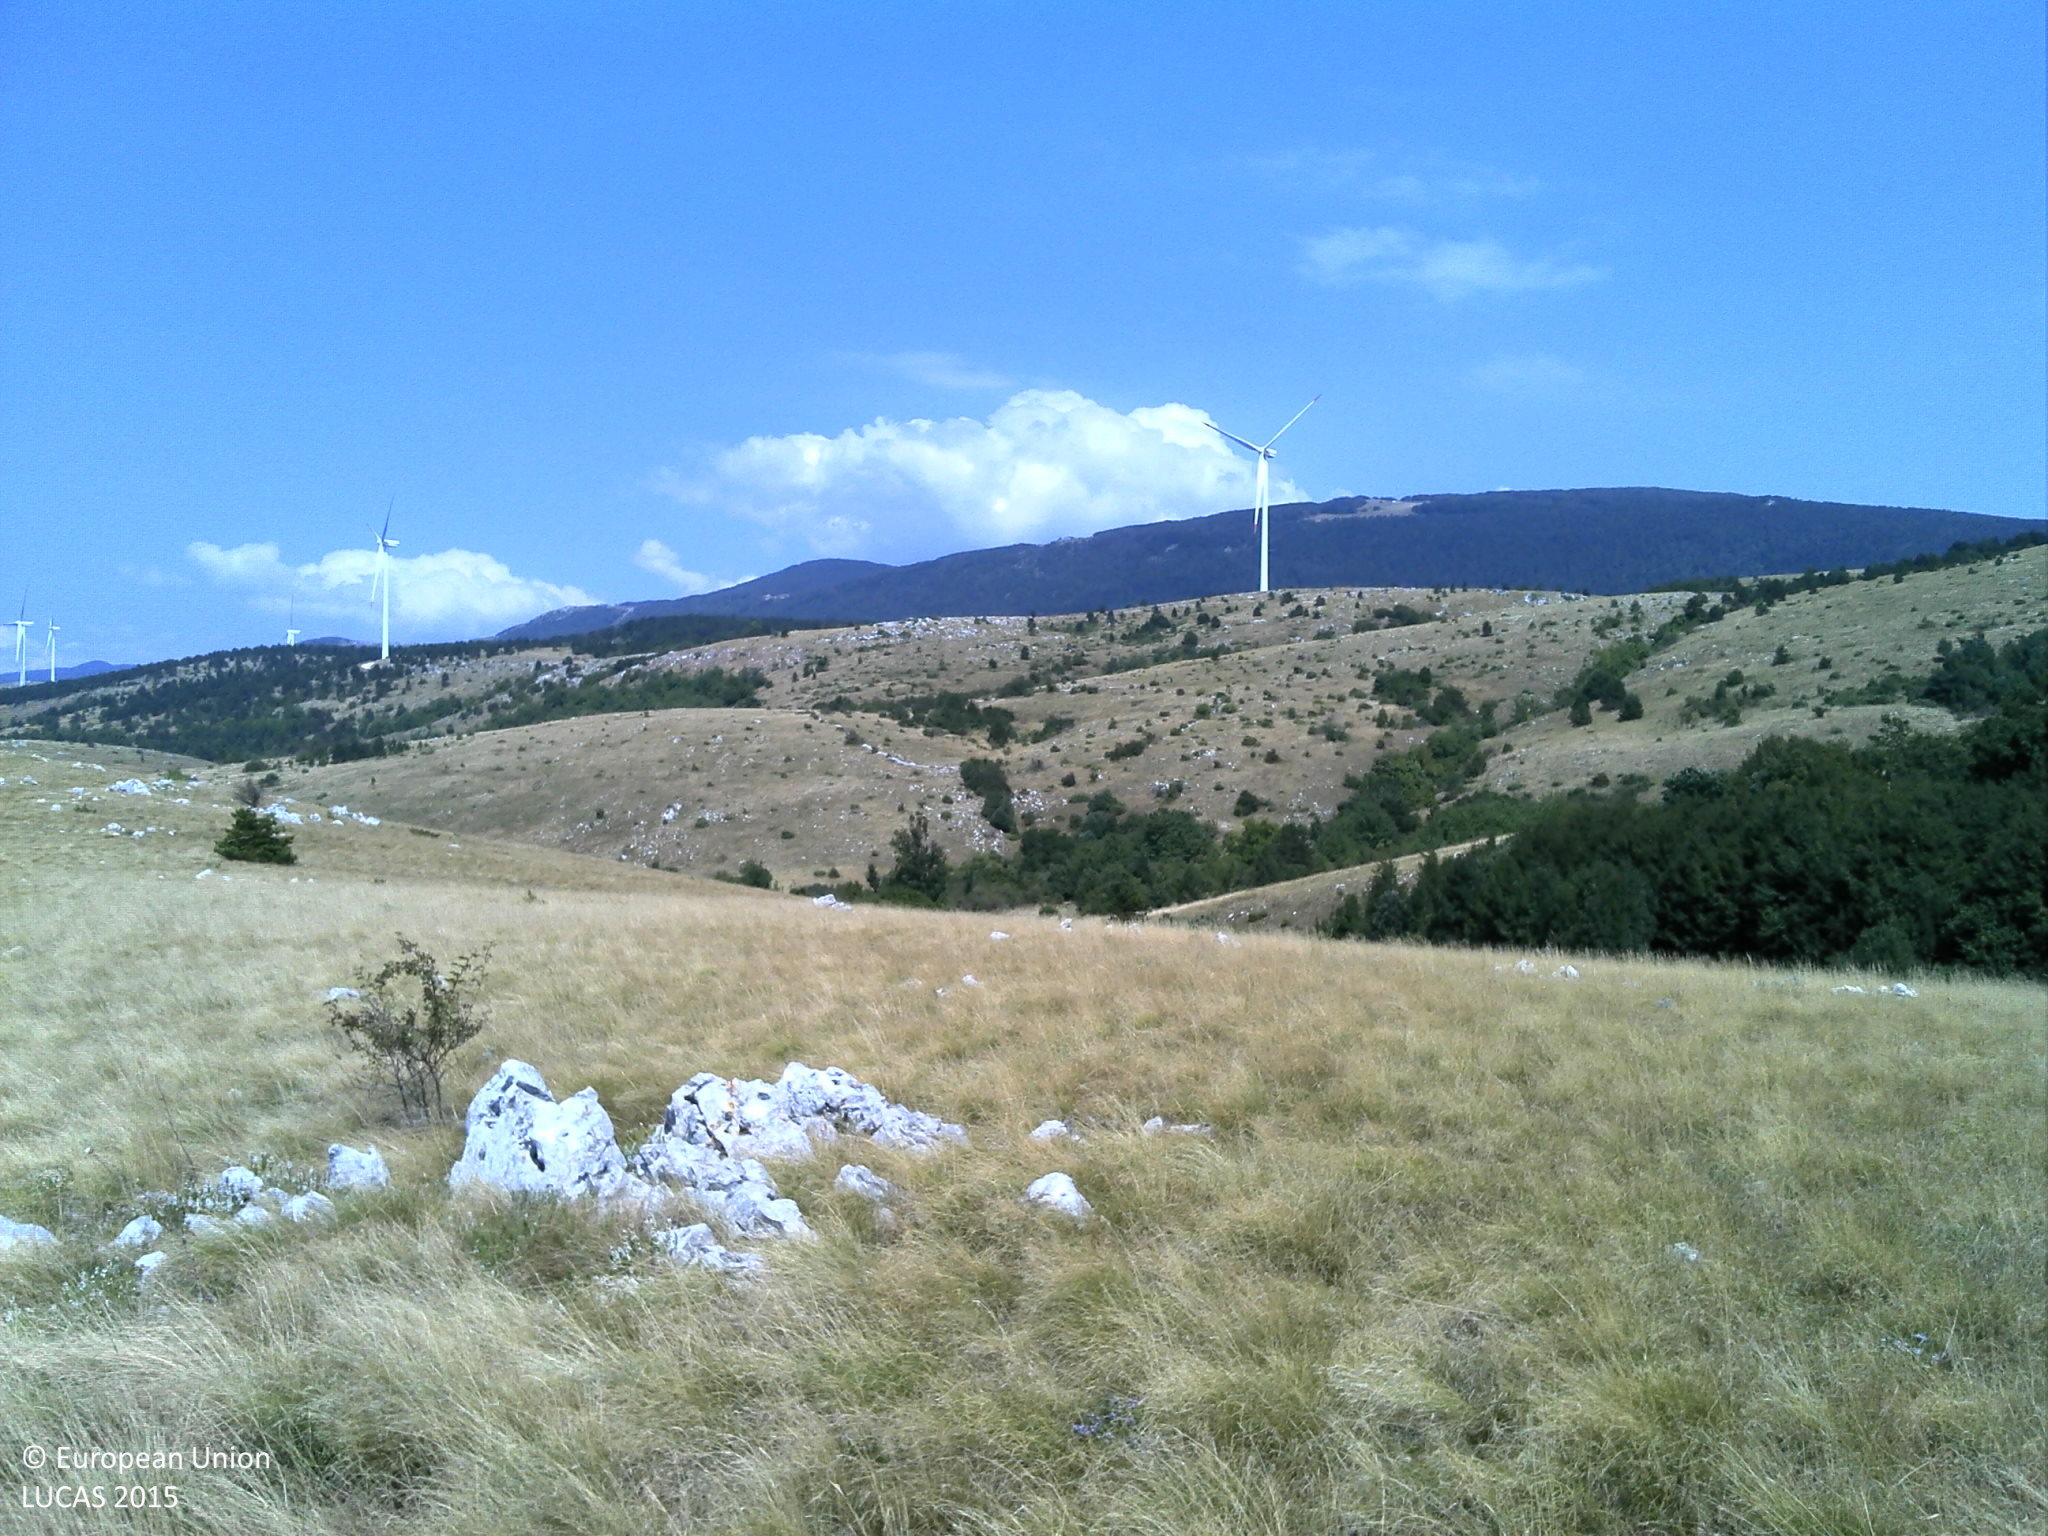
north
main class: Grassland
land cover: Grassland without tree/shrub cover
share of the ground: > 75 %
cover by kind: herbaceous plants 90 %, consolidated bare surface 5 %, unconsolidated bare surface 5 %
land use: Semi-natural and natural areas not in use
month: August
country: HR
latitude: 45.0281
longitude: 14.9316
